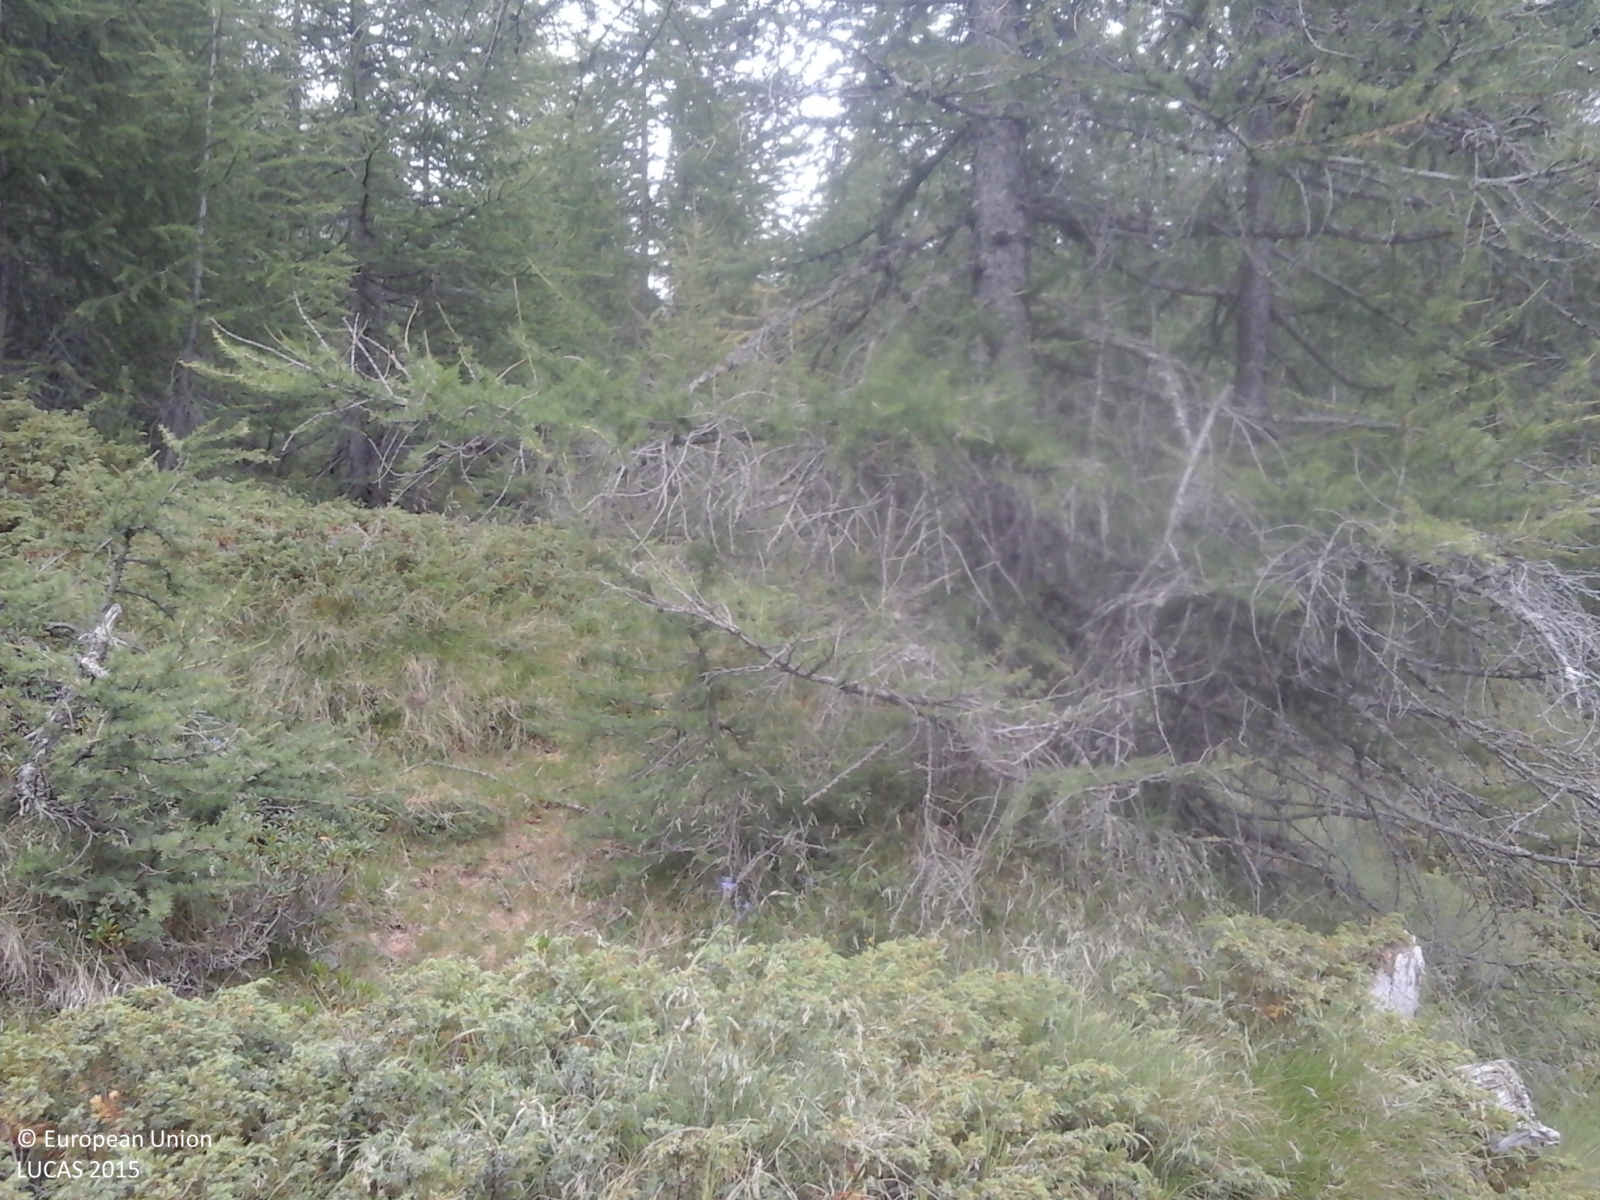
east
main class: Woodland
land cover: Spruce dominated coniferous woodland
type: alpine coniferous forest
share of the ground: > 75 %
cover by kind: coniferous forest trees 90 %, shrubs 10 %
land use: Semi-natural and natural areas not in use
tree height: > 5 m
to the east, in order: Spruce dominated coniferous woodland; Rivers and streams; Spruce dominated coniferous woodland
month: July
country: IT
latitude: 46.2971
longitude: 9.9352
